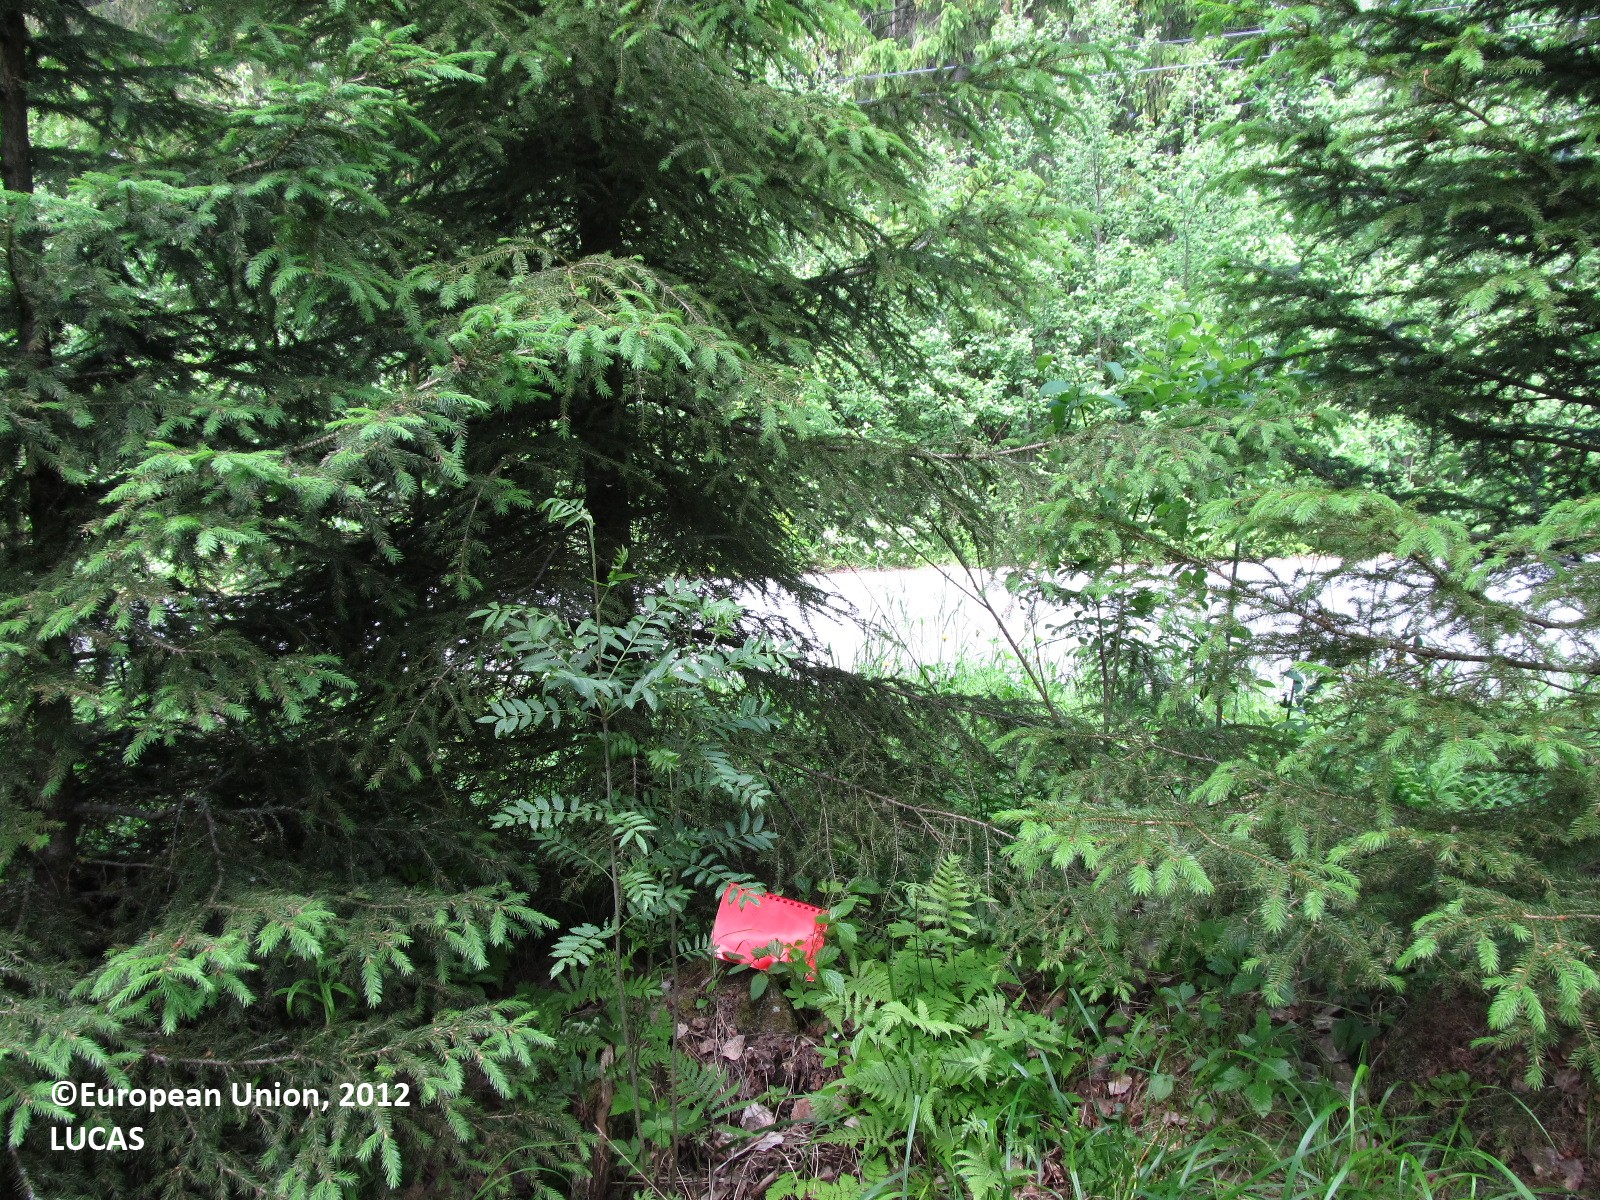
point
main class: Woodland
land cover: Broadleaved woodland
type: boreal forest
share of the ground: 50 - 75 %
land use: Forestry
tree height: > 5 m
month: June
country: FI
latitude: 62.8760
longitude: 27.4834
